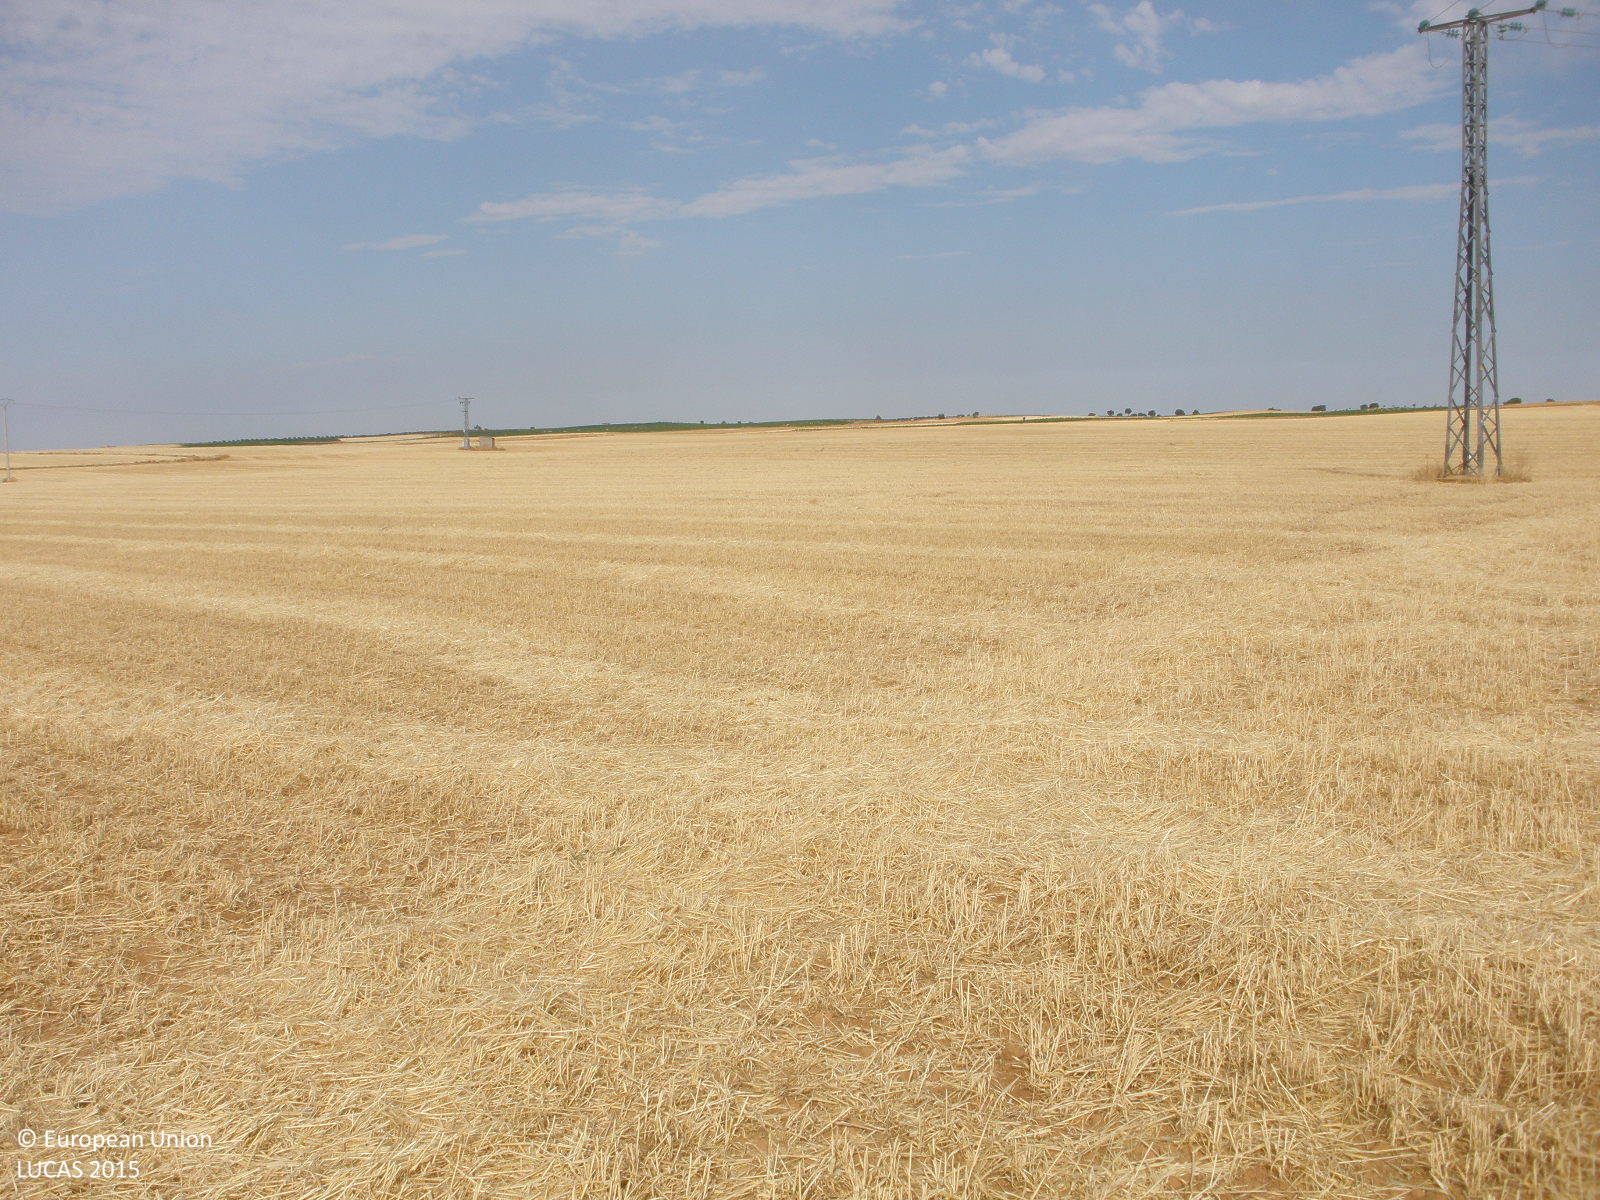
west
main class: Cropland
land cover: Barley
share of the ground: < 10 %
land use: Agriculture (excluding fallow land and kitchen gardens)
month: July
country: ES
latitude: 39.7912
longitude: -3.2074
